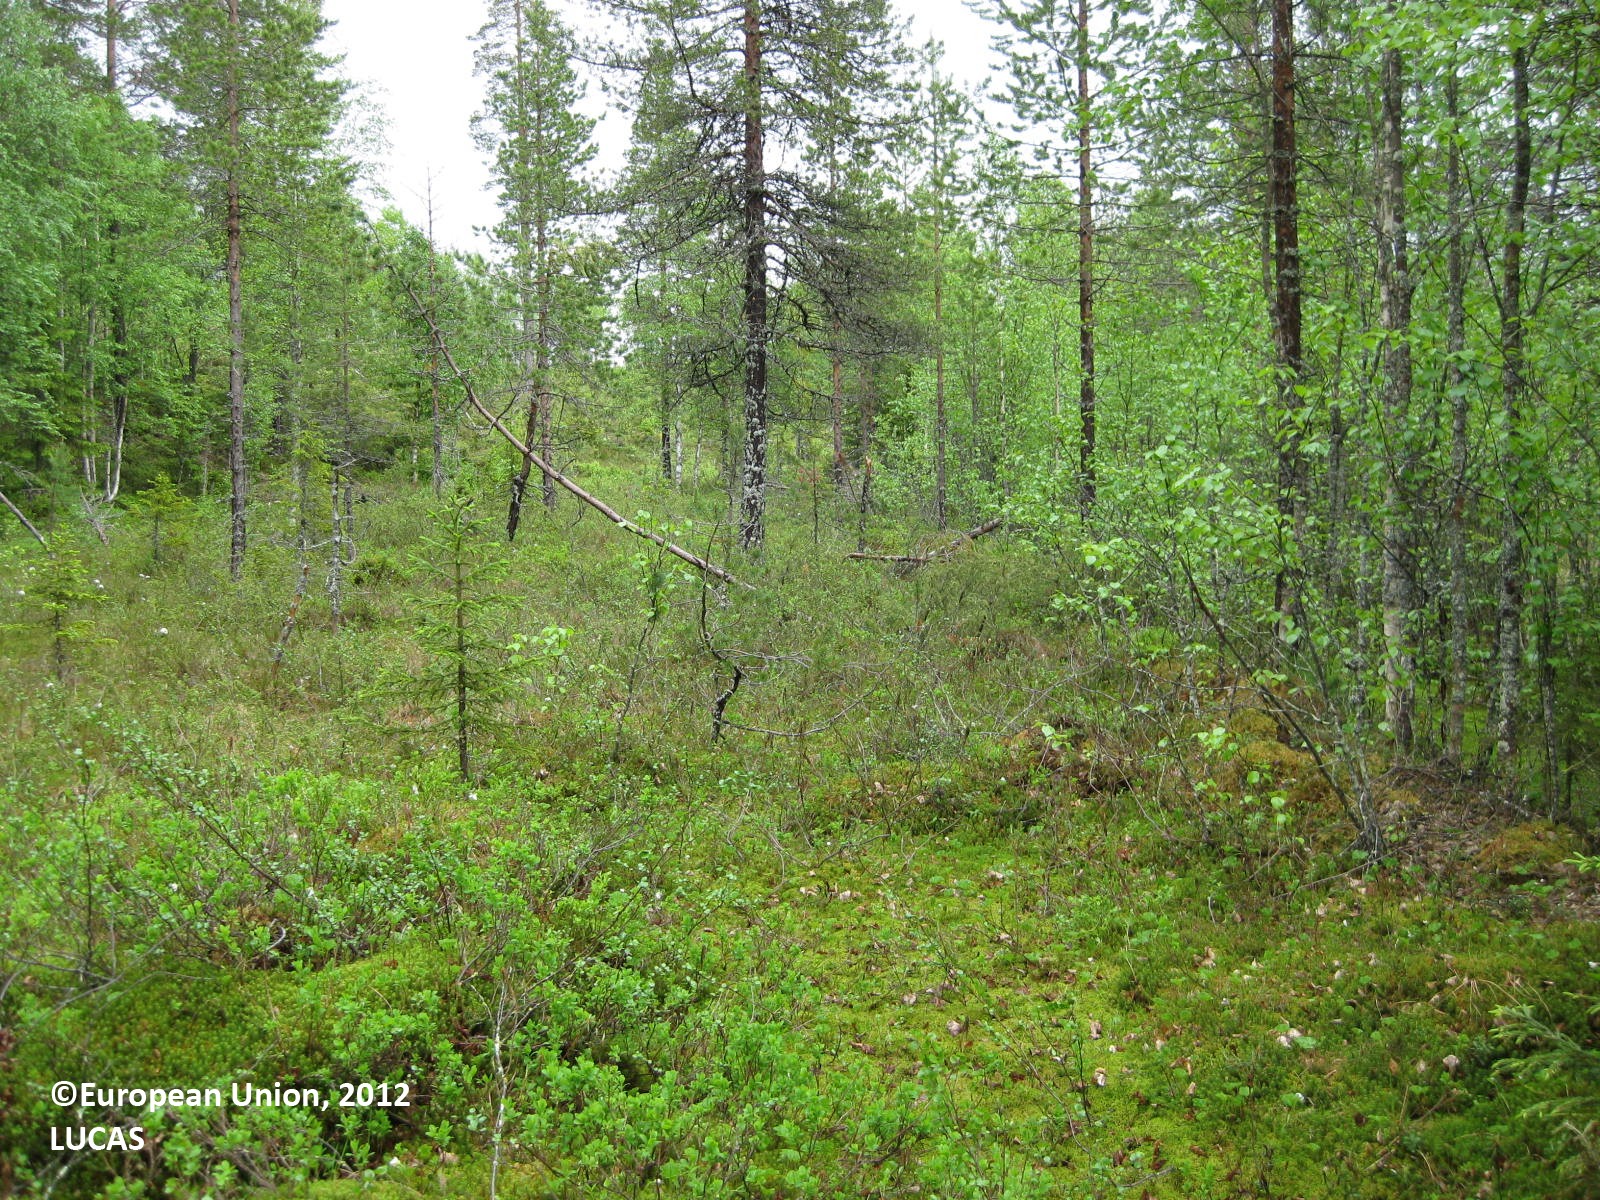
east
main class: Woodland
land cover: Other mixed woodland
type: boreal forest
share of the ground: 50 - 75 %
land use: Forestry
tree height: > 5 m
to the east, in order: Other mixed woodland; Pine dominated mixed woodland; Ditches and canals; Pine dominated mixed woodland; Ditches and canals; Other mixed woodland; Pine dominated mixed woodland; Other mixed woodland; Pine dominated mixed woodland
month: June
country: FI
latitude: 65.1107
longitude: 28.9439
